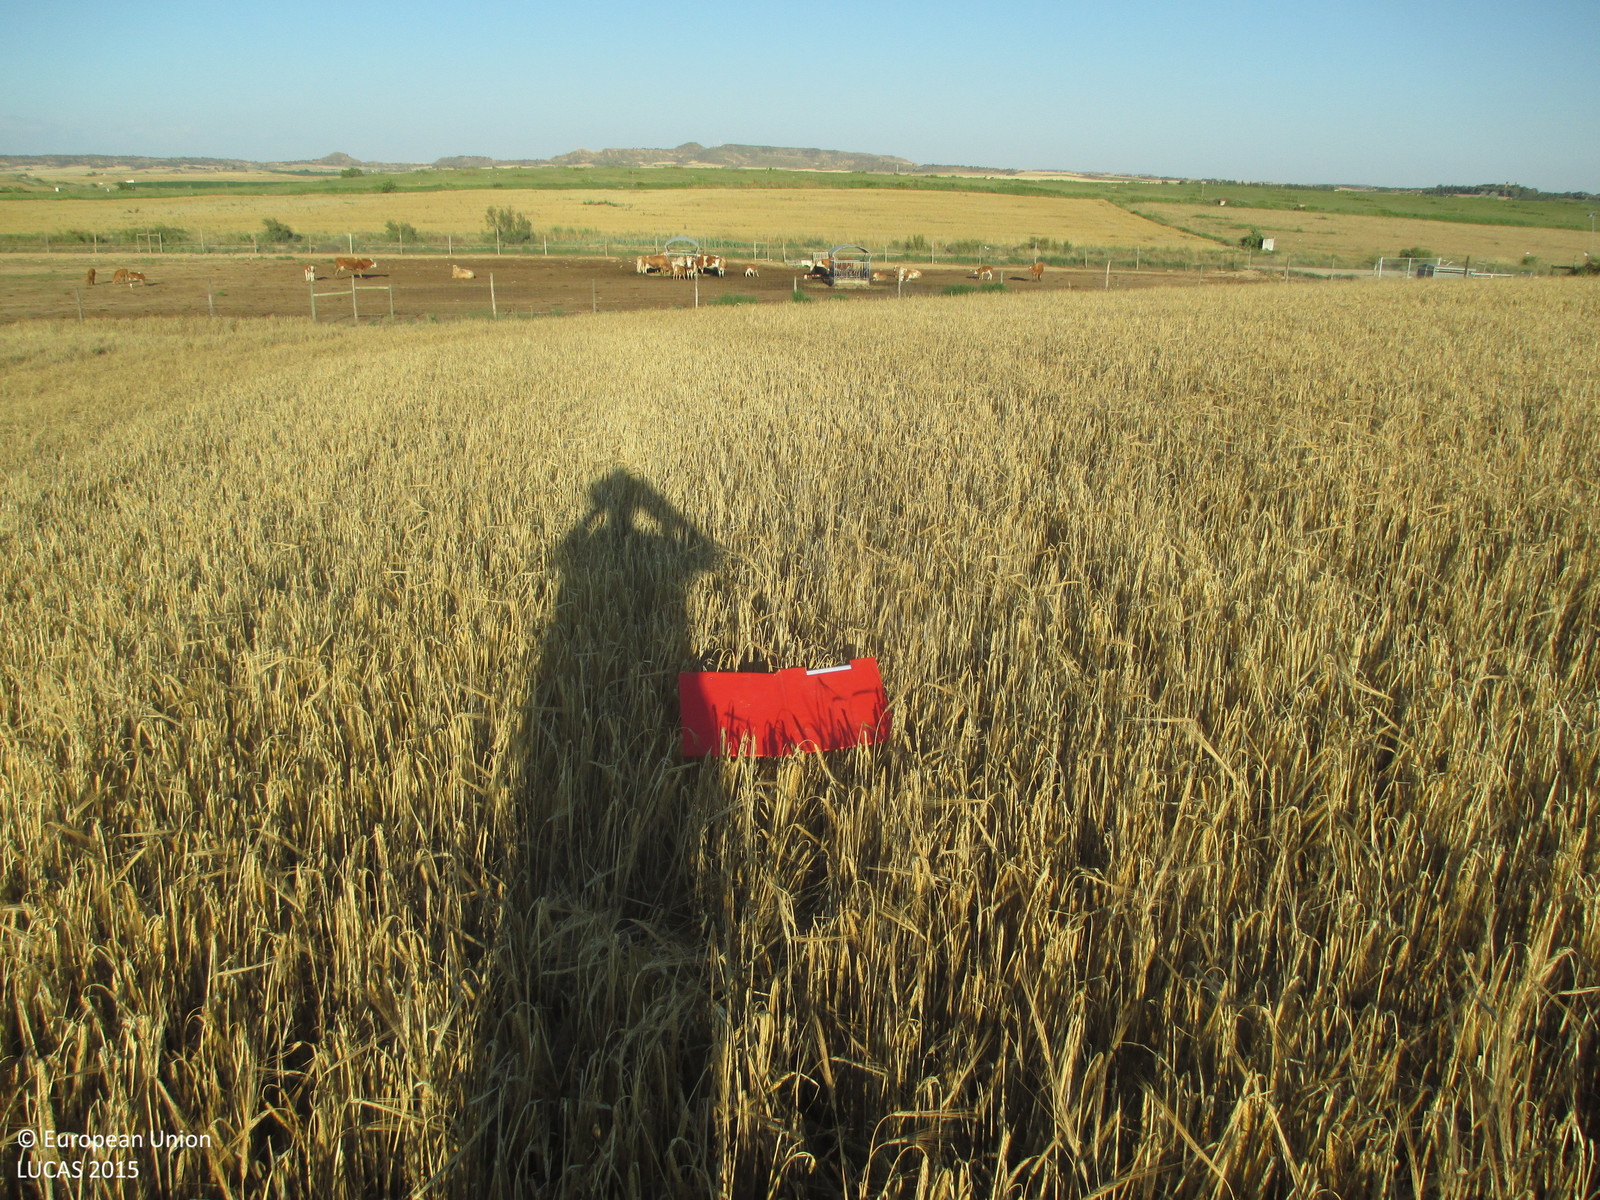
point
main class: Cropland
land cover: Barley
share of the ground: > 75 %
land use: Agriculture (excluding fallow land and kitchen gardens)
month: June
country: ES
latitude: 42.0445
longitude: -0.3995
